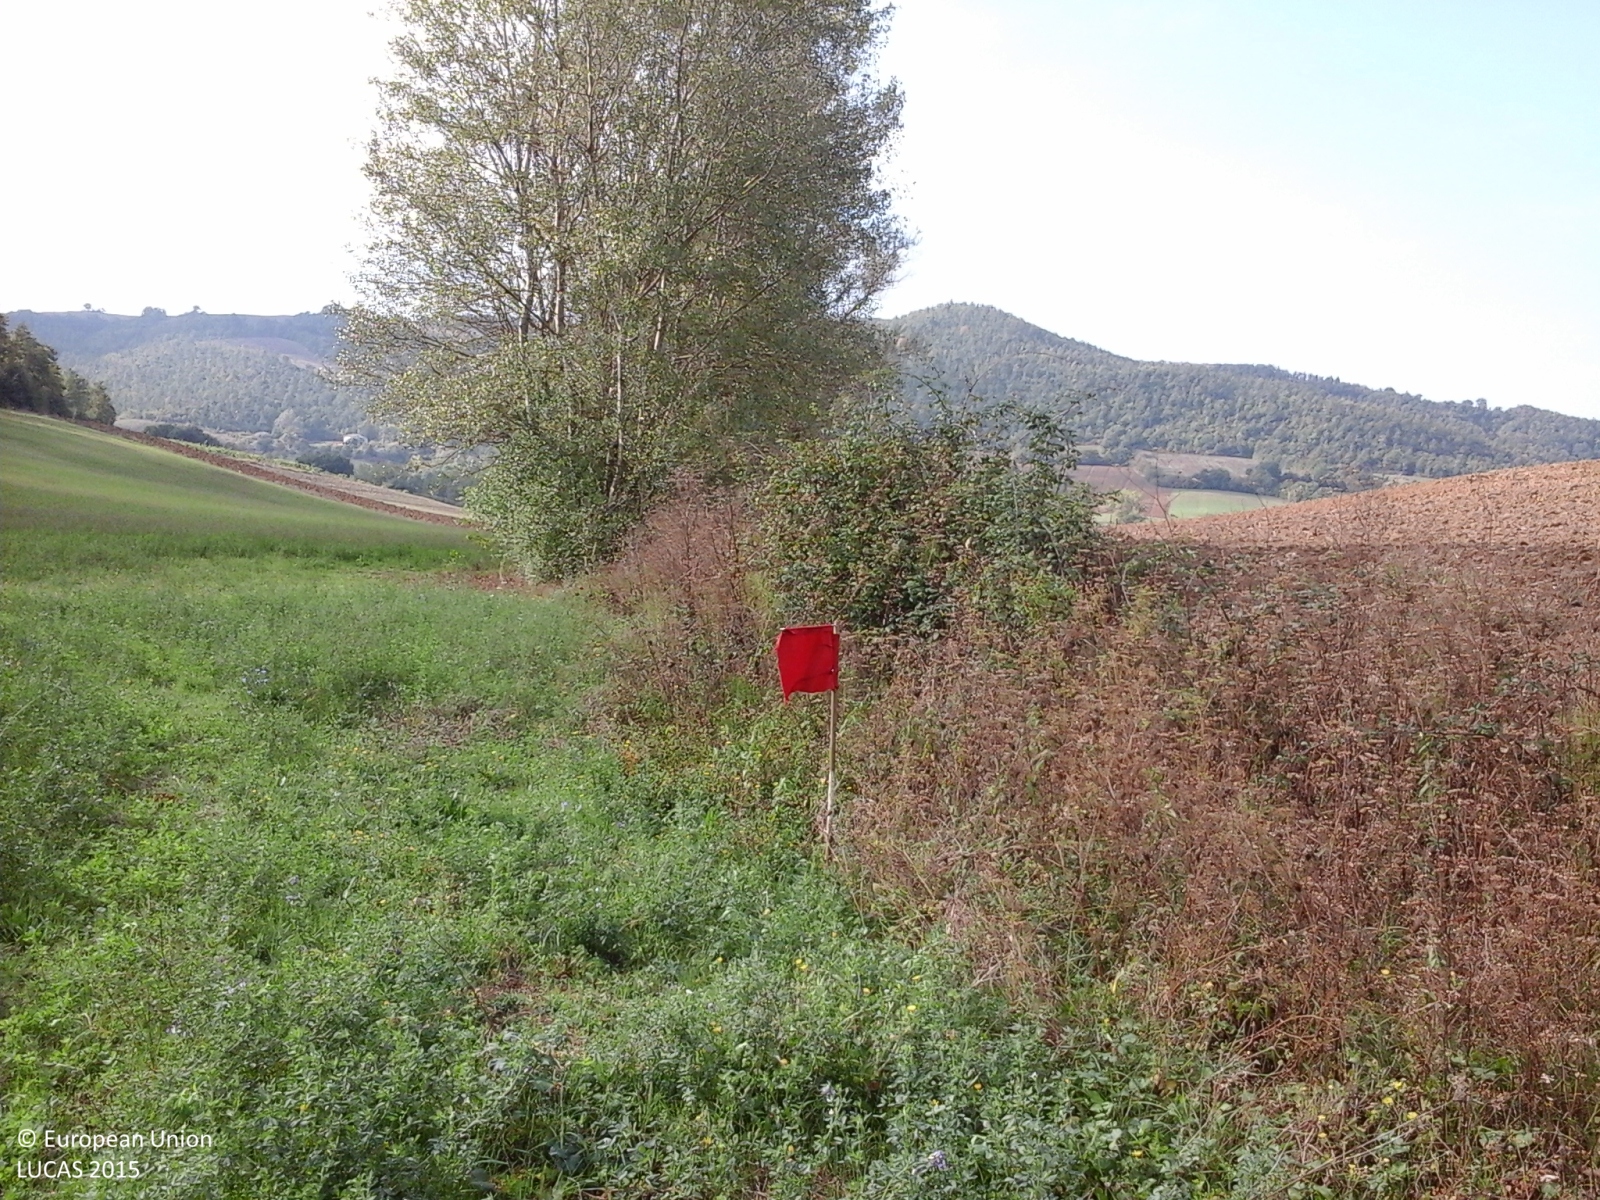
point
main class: Cropland
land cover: Lucerne
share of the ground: > 75 %
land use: Agriculture (excluding fallow land and kitchen gardens)
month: October
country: IT
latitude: 43.2880
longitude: 12.6425
